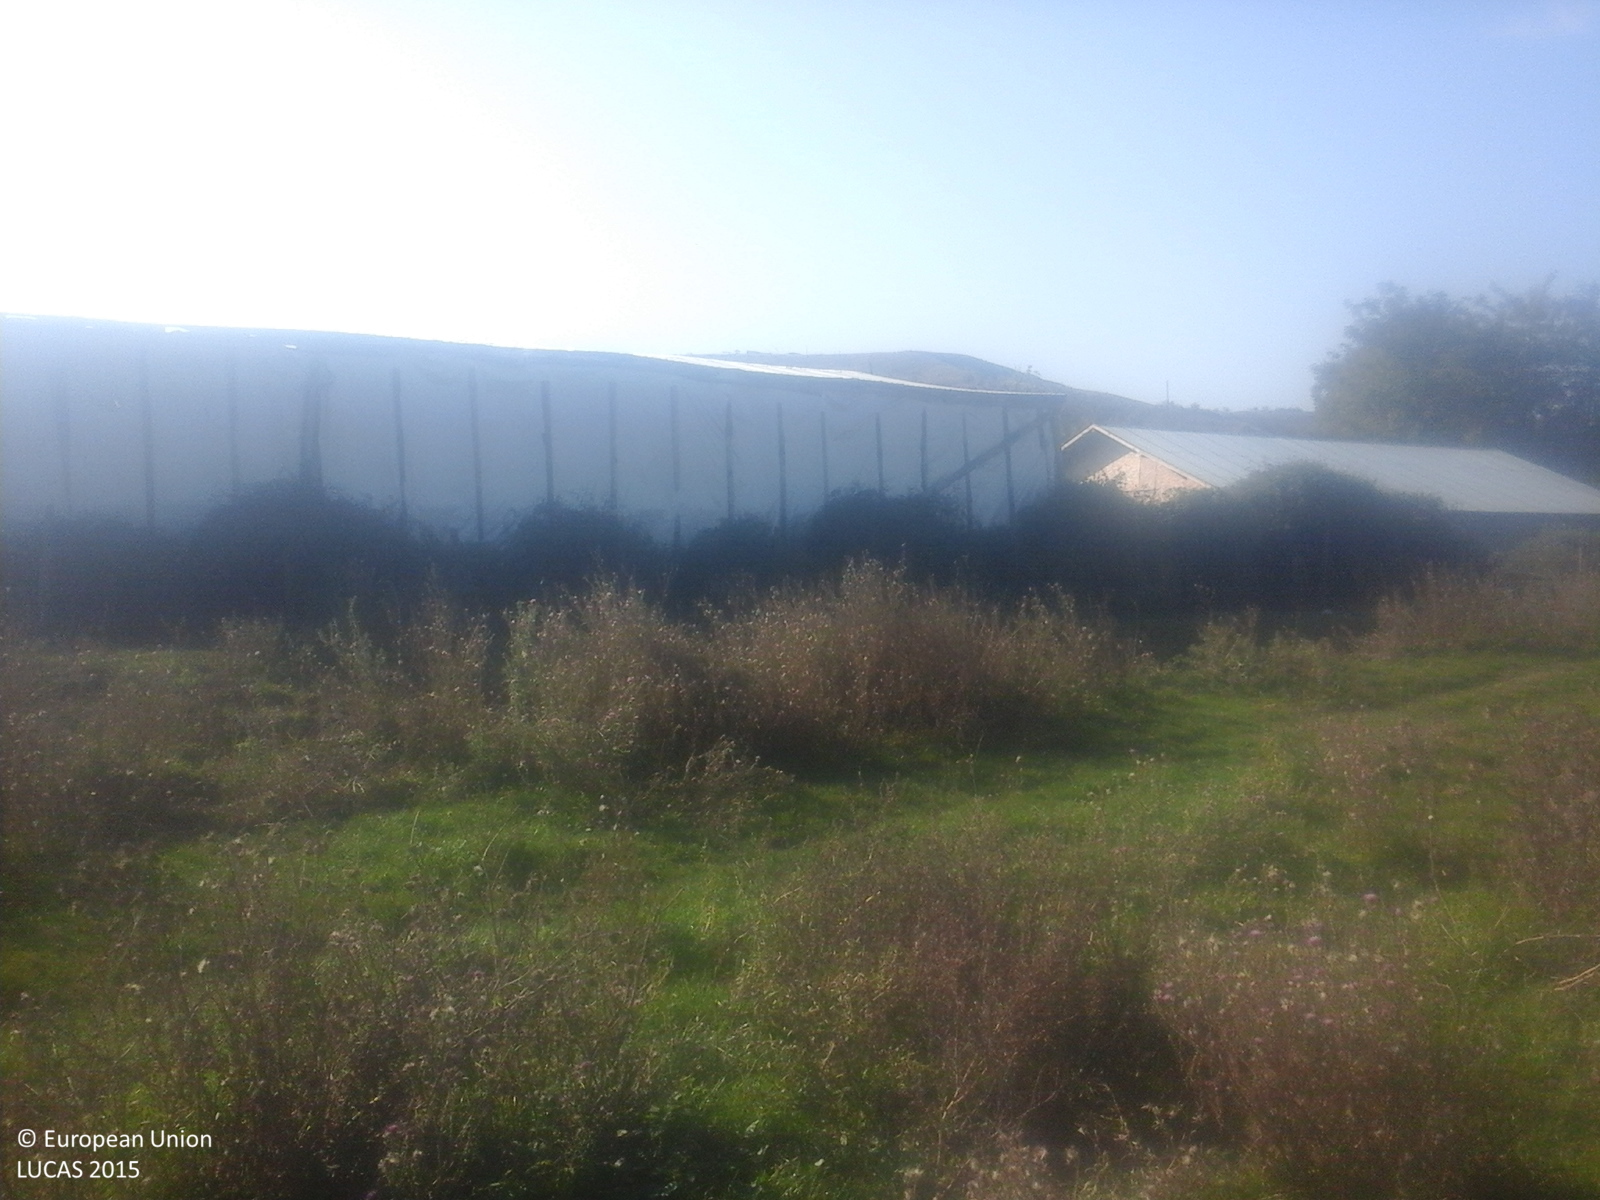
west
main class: Grassland
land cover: Grassland without tree/shrub cover
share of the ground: > 75 %
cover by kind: herbaceous plants 100 %
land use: Agriculture (excluding fallow land and kitchen gardens)
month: October
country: RO
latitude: 45.2921
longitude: 26.8754
